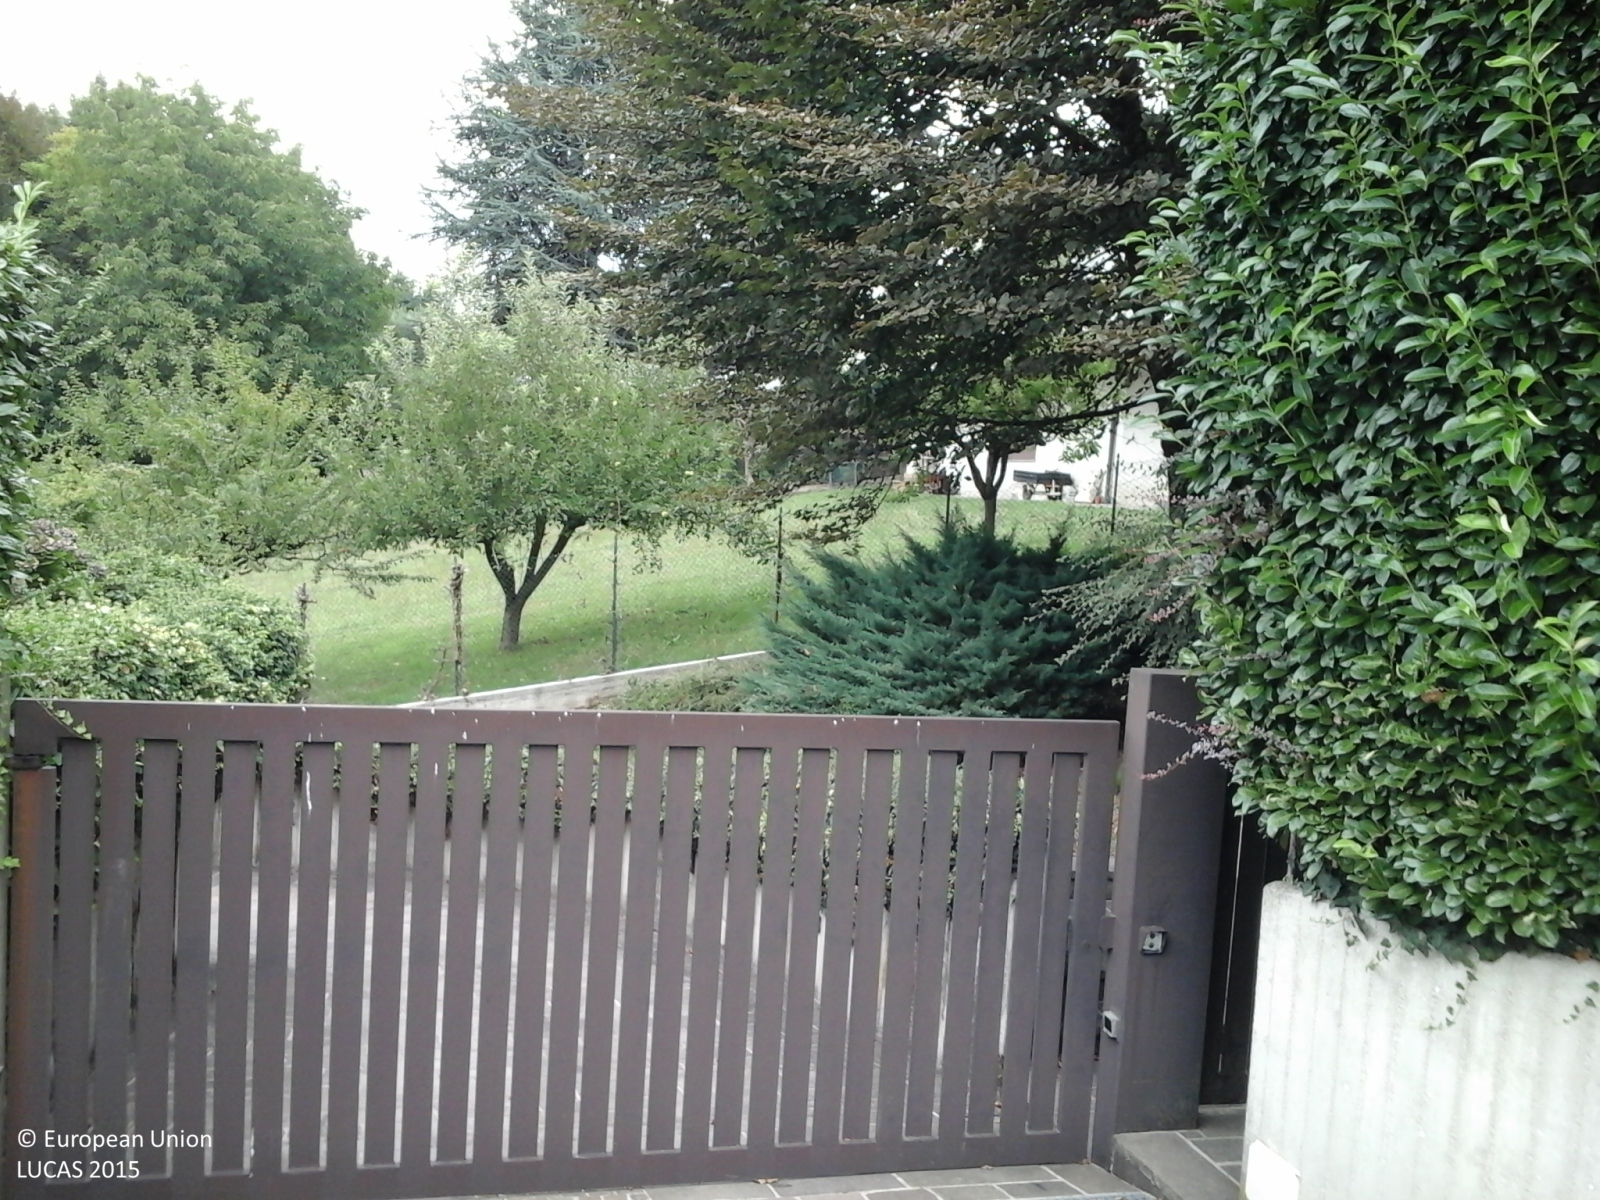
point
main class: Grassland
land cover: Grassland with sparse tree/shrub cover
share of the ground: > 75 %
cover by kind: herbaceous plants 85 %, shrubs 10 %, broadleaved forest trees 5 %
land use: Residential
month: August
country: IT
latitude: 45.7530
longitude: 9.1144
